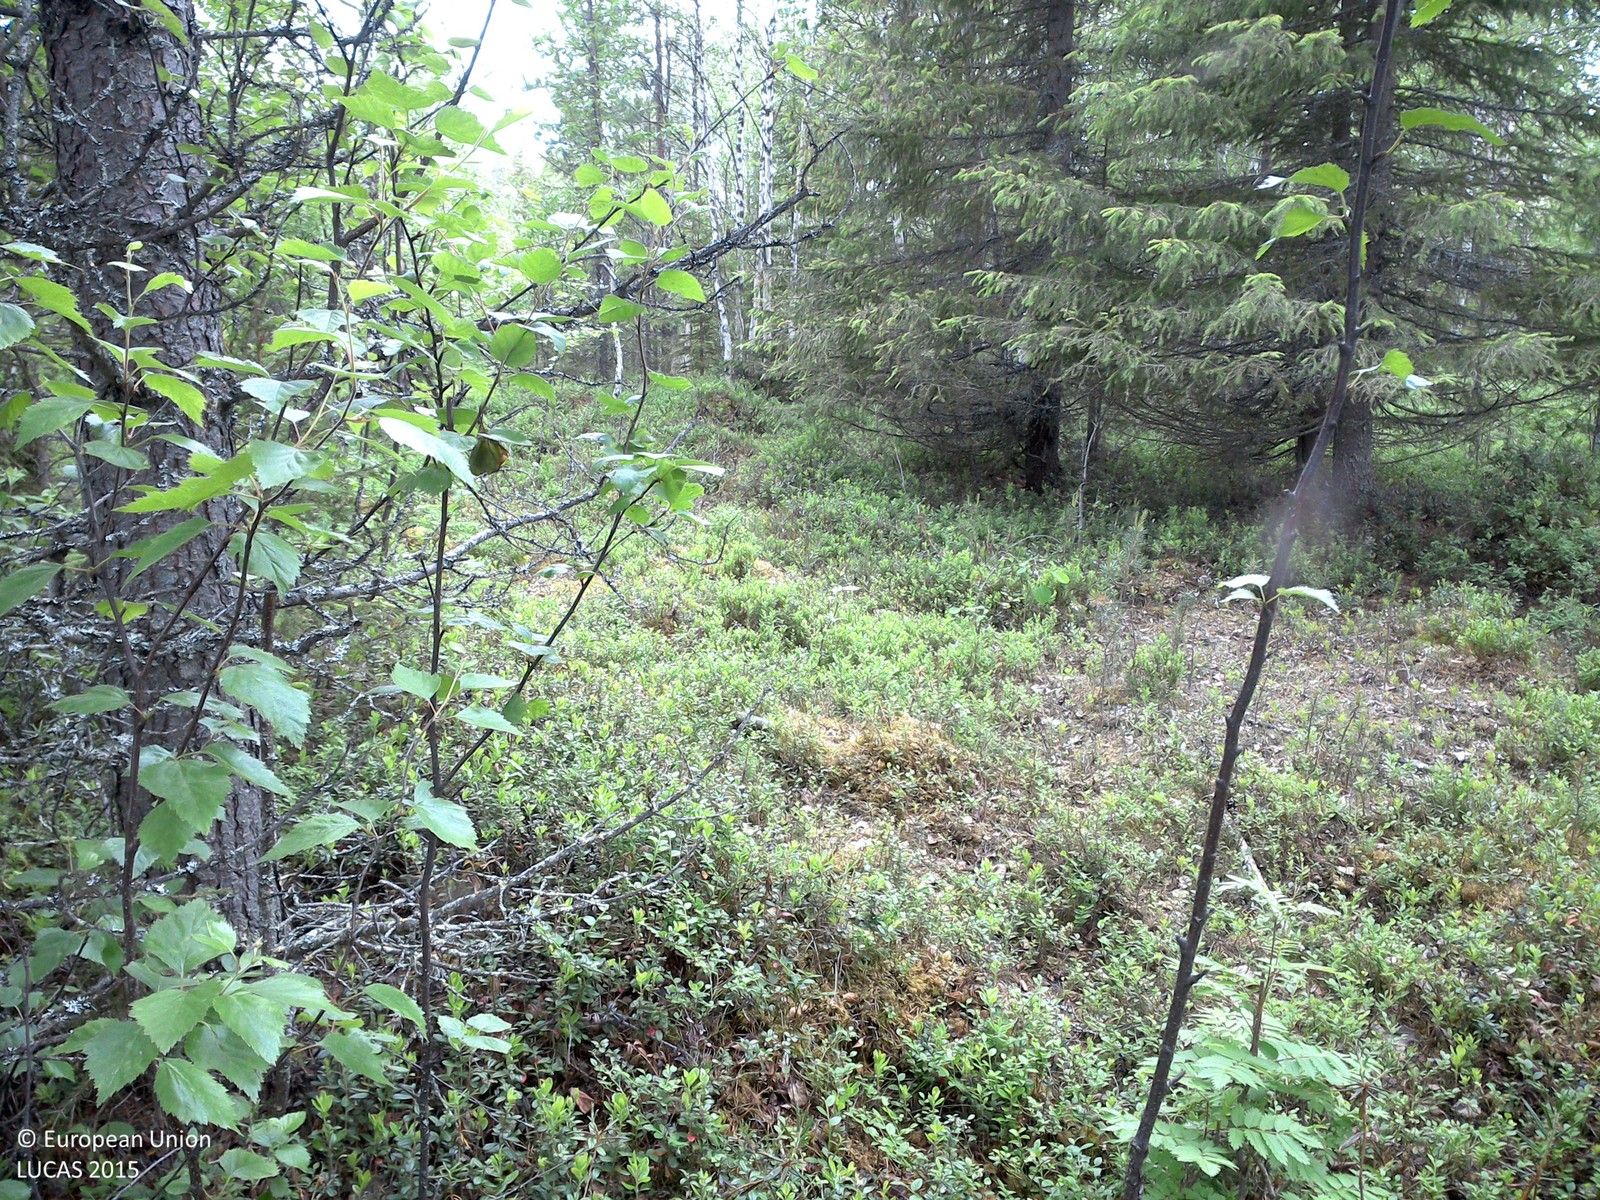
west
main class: Woodland
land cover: Pine dominated mixed woodland
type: boreal forest
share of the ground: 25 - 50 %
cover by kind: shrubs 60 %, coniferous forest trees 25 %, broadleaved forest trees 10 %, lichens and mosses 5 %
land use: Forestry
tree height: > 5 m
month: July
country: SE
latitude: 66.8554
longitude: 23.7300
